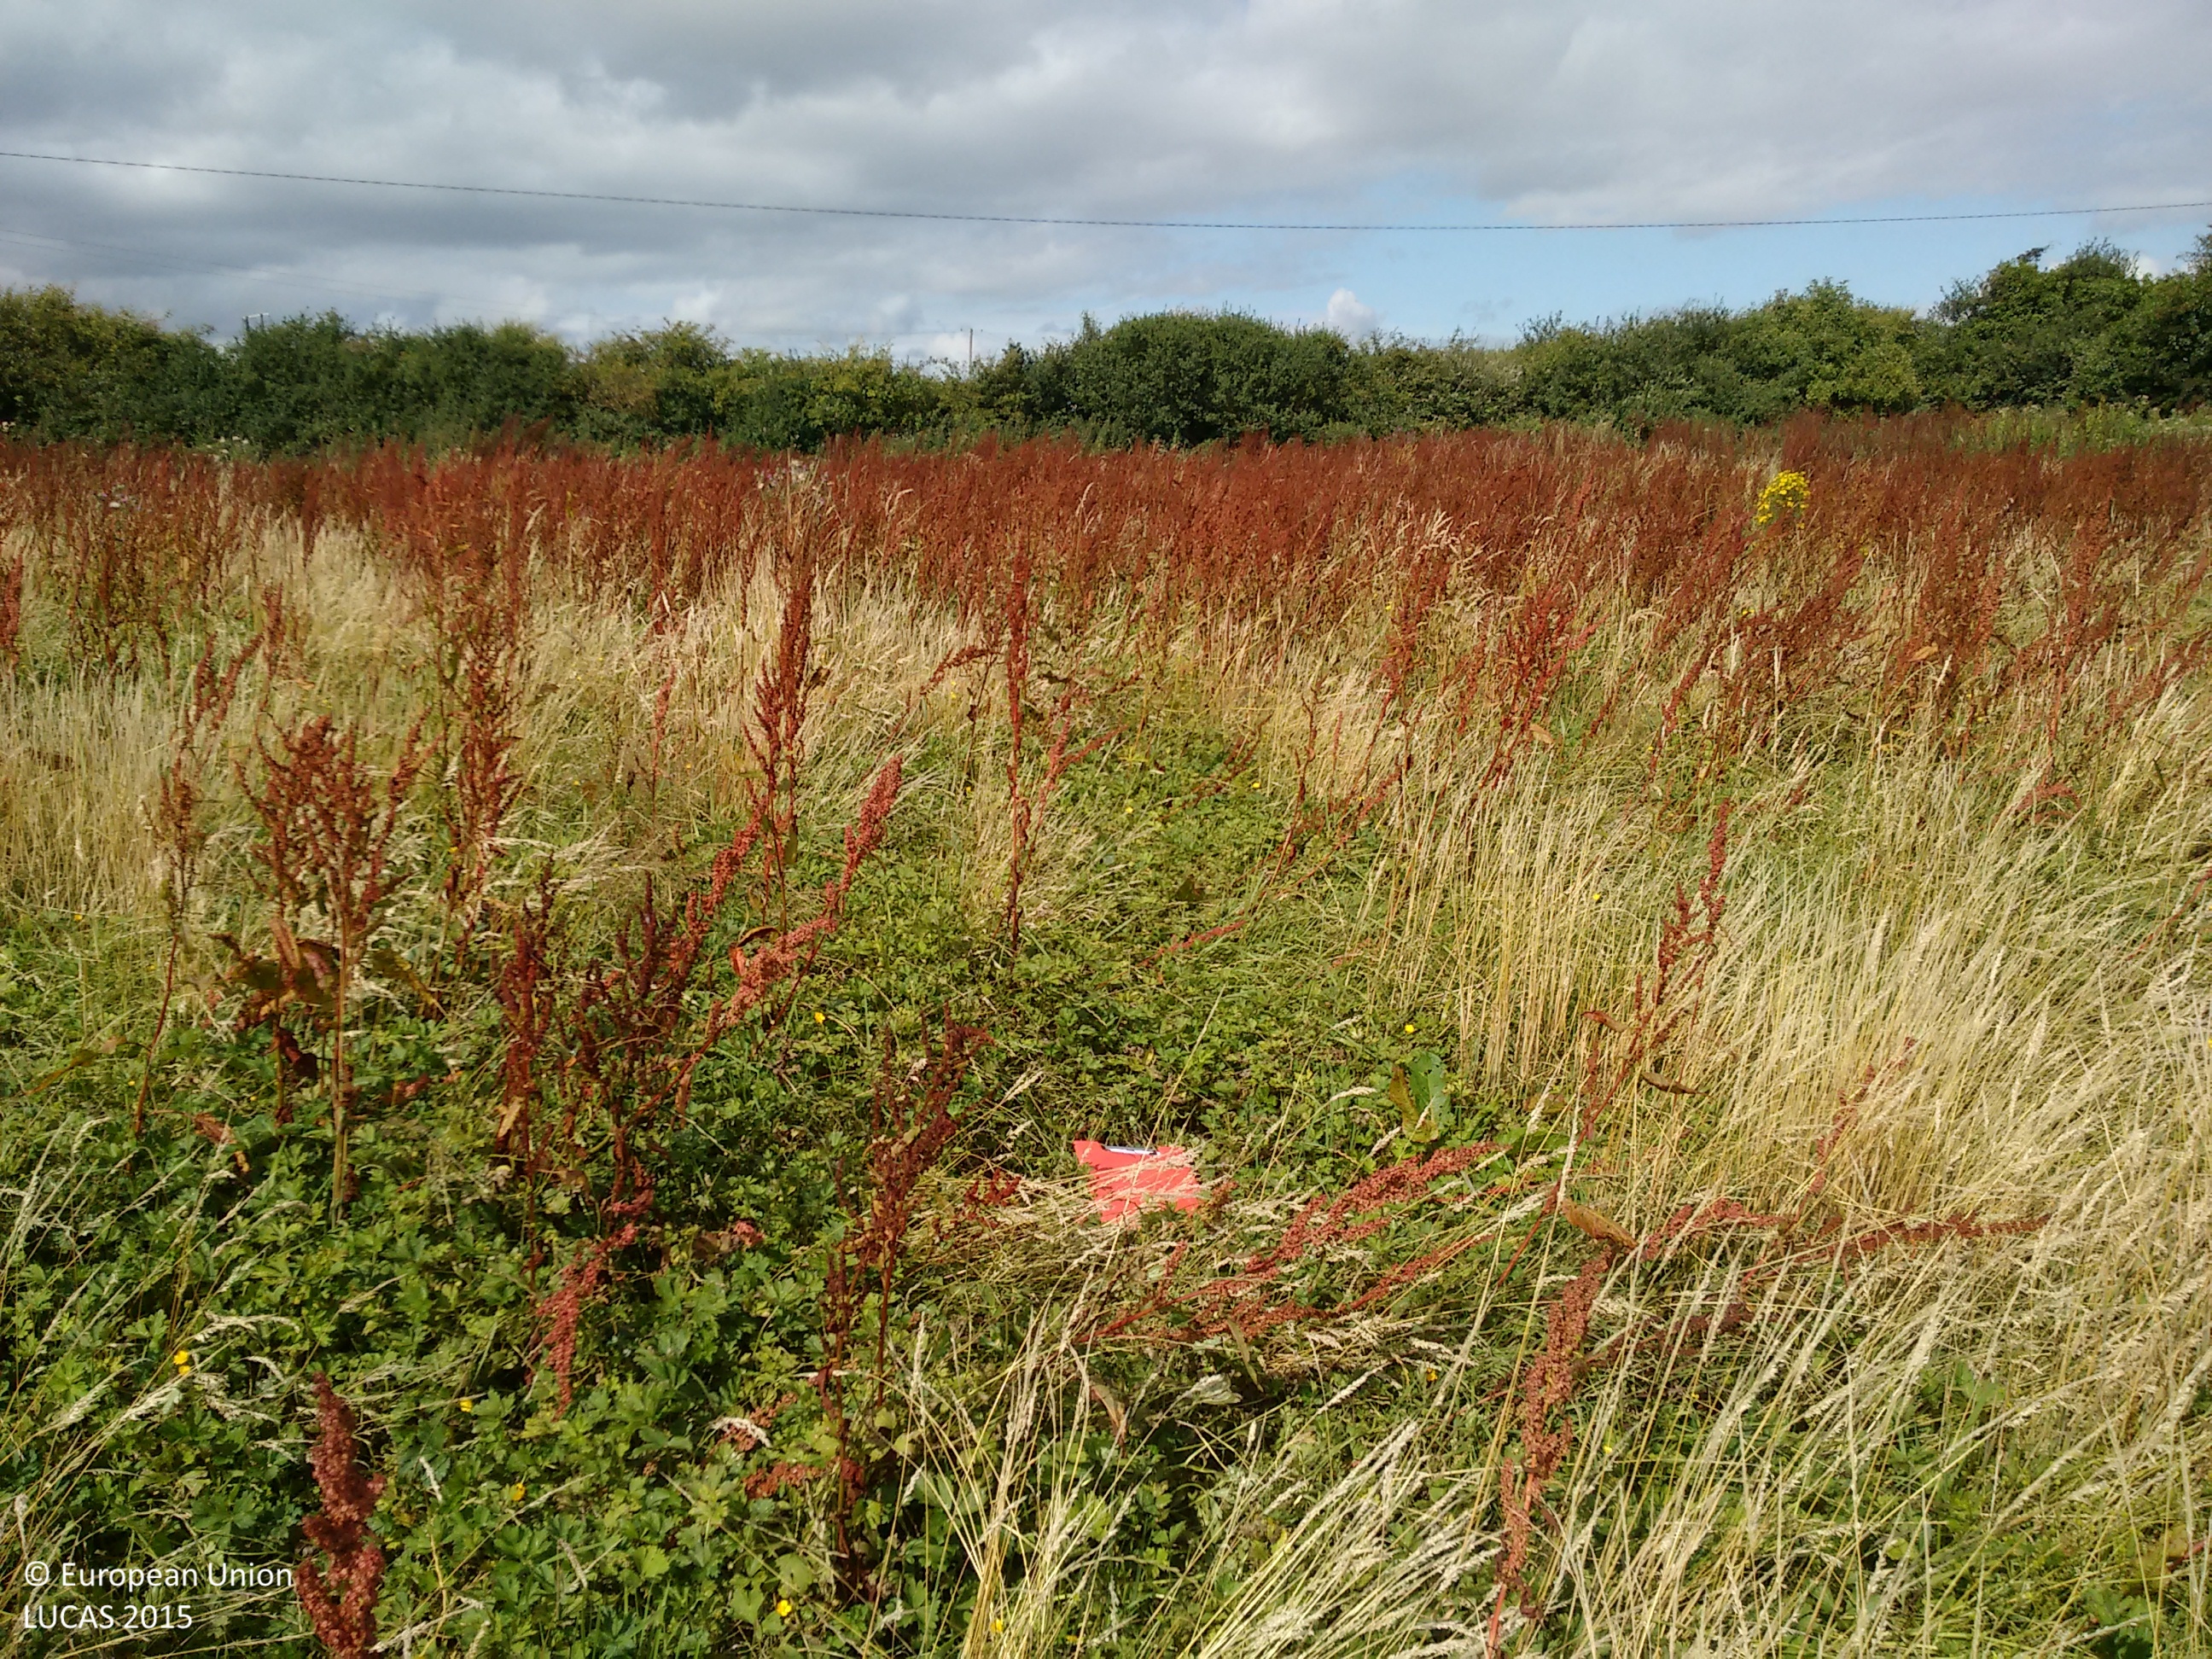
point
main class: Grassland
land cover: Spontaneously vegetated surfaces
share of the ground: > 75 %
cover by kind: herbaceous plants 95 %, shrubs 5 %
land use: Fallow land
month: August
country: IE
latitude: 53.8133
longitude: -6.4201
